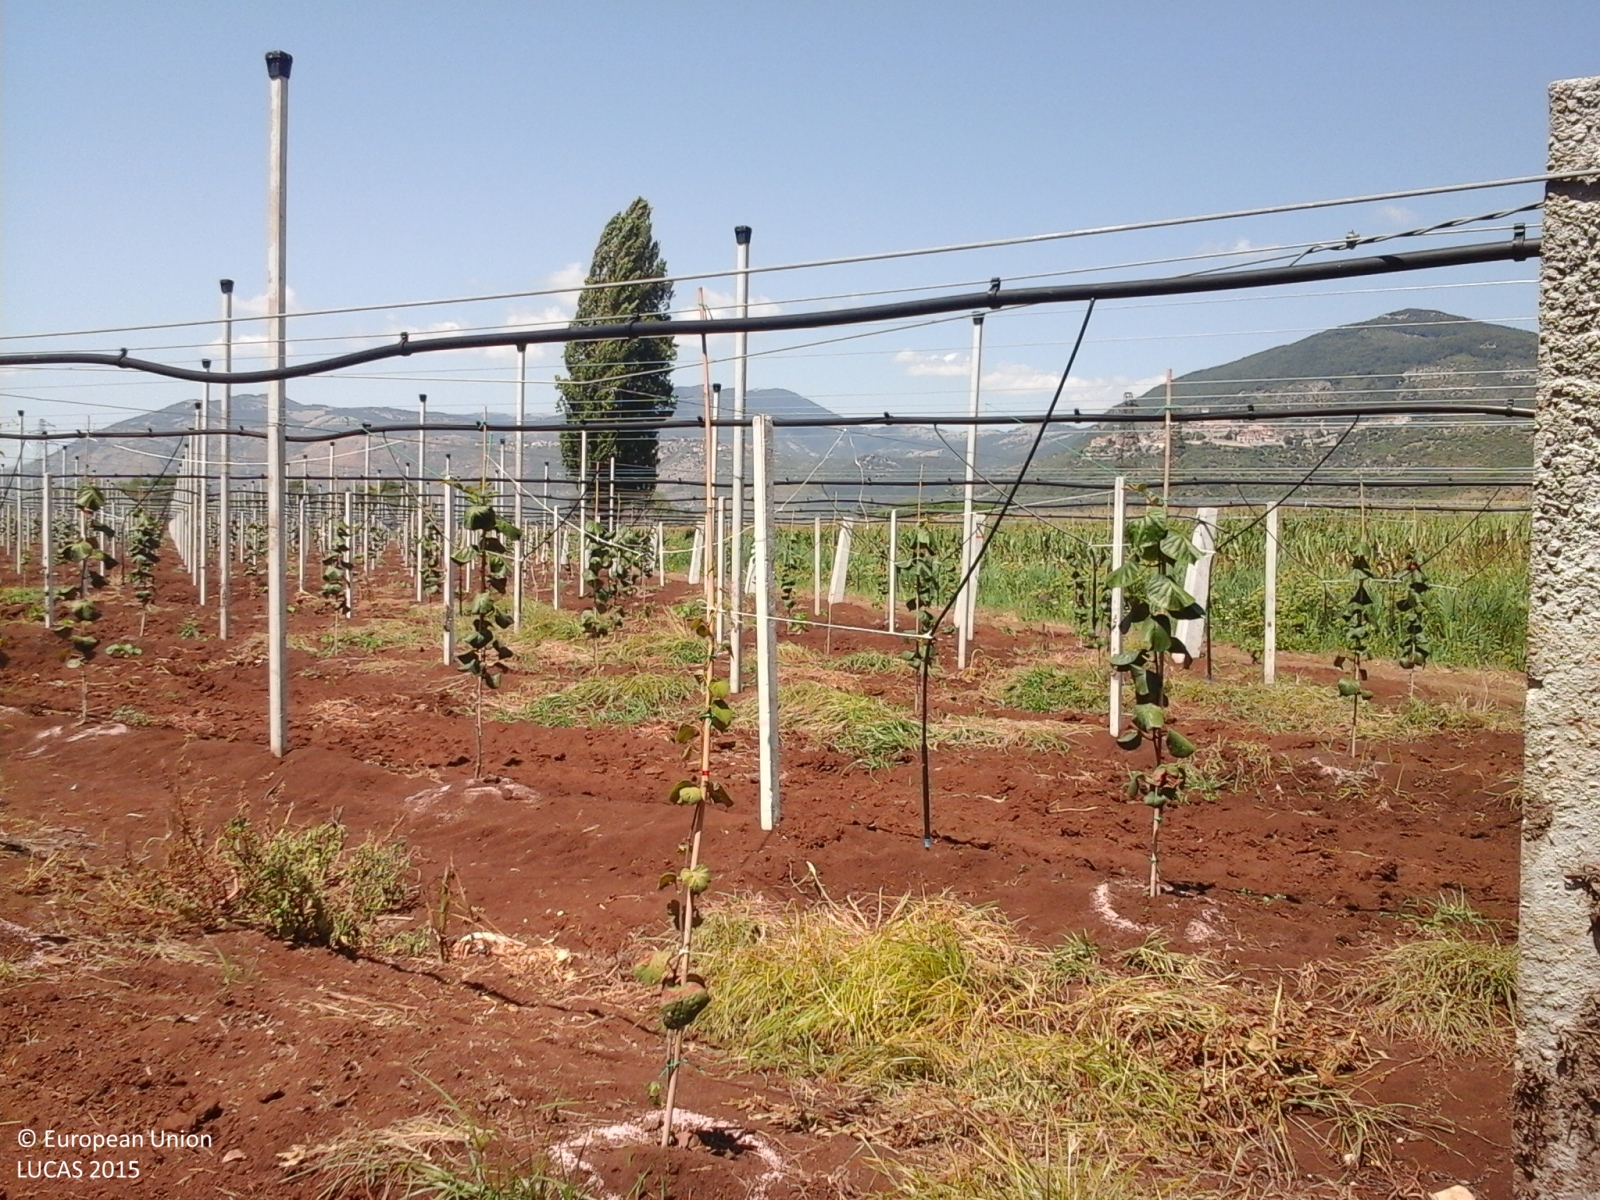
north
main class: Cropland
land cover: Other fruit trees and berries
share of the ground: 50 - 75 %
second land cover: Other bare soil
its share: > 75 %
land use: Agriculture (excluding fallow land and kitchen gardens)
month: July
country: IT
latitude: 41.5256
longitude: 12.9724
